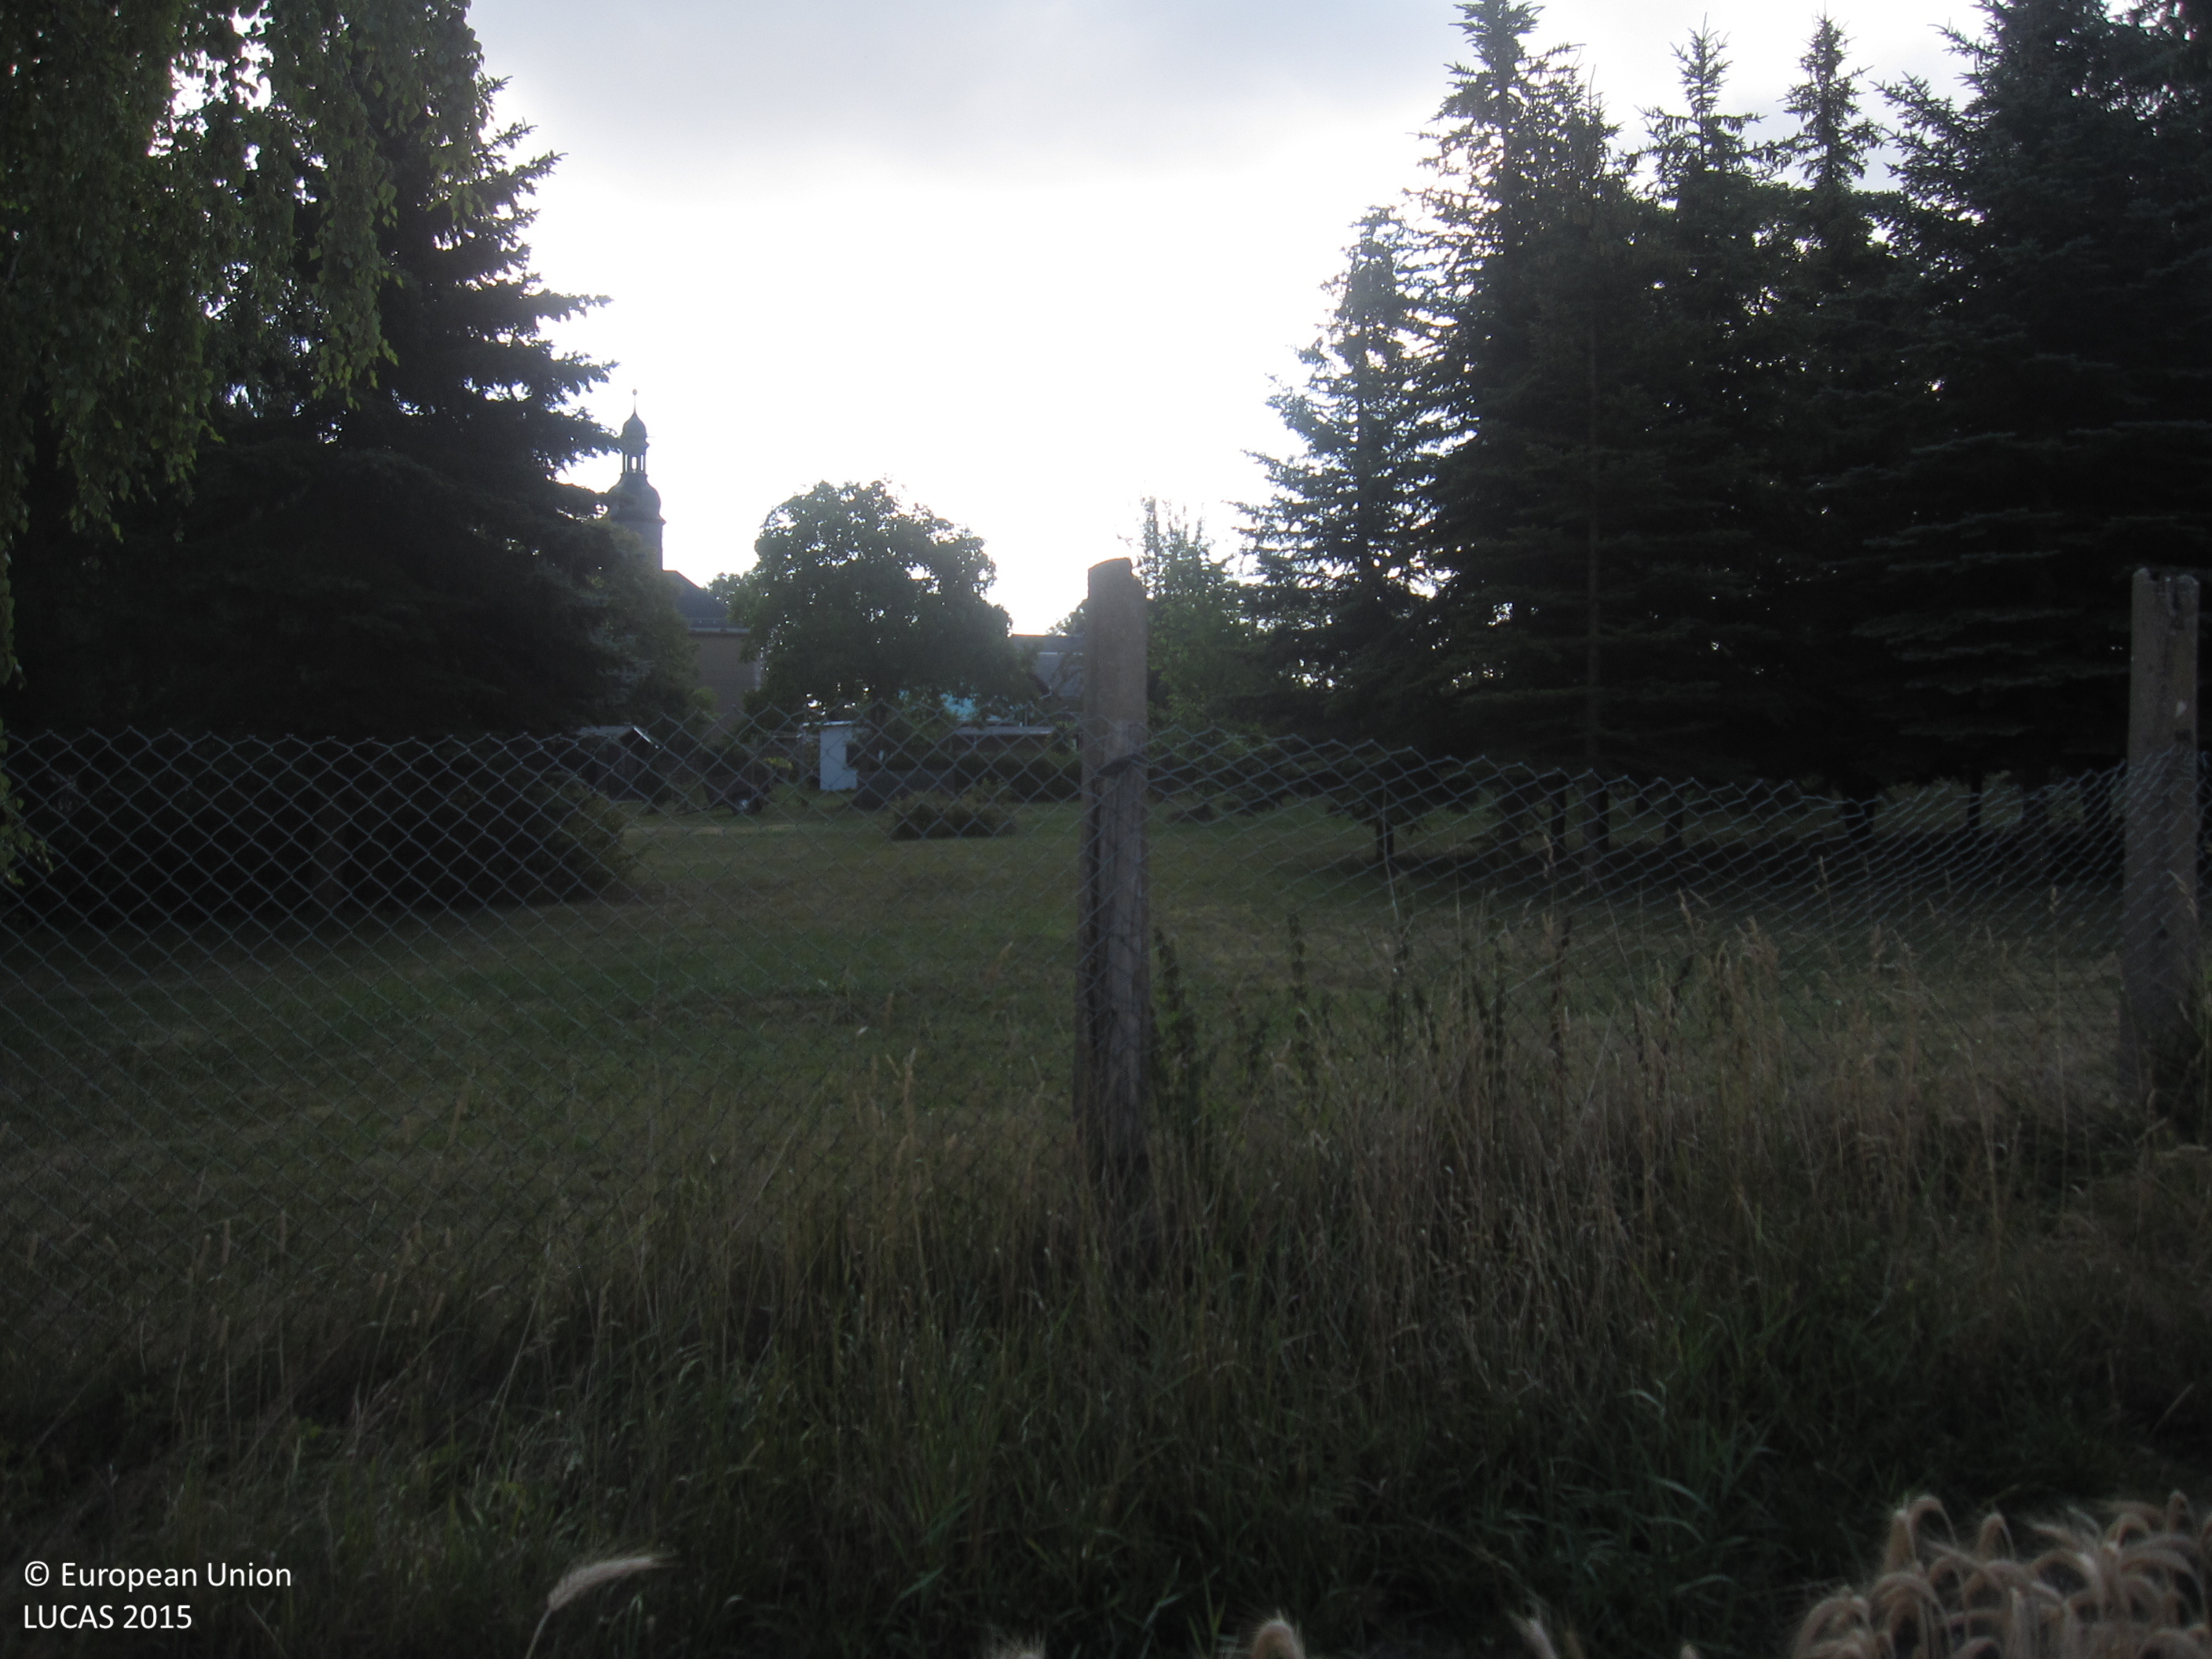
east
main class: Cropland
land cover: Durum wheat
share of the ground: > 75 %
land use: Agriculture (excluding fallow land and kitchen gardens)
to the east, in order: Durum wheat; Artificial constructions in urban areas
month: July
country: DE
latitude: 50.4188
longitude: 11.9841
